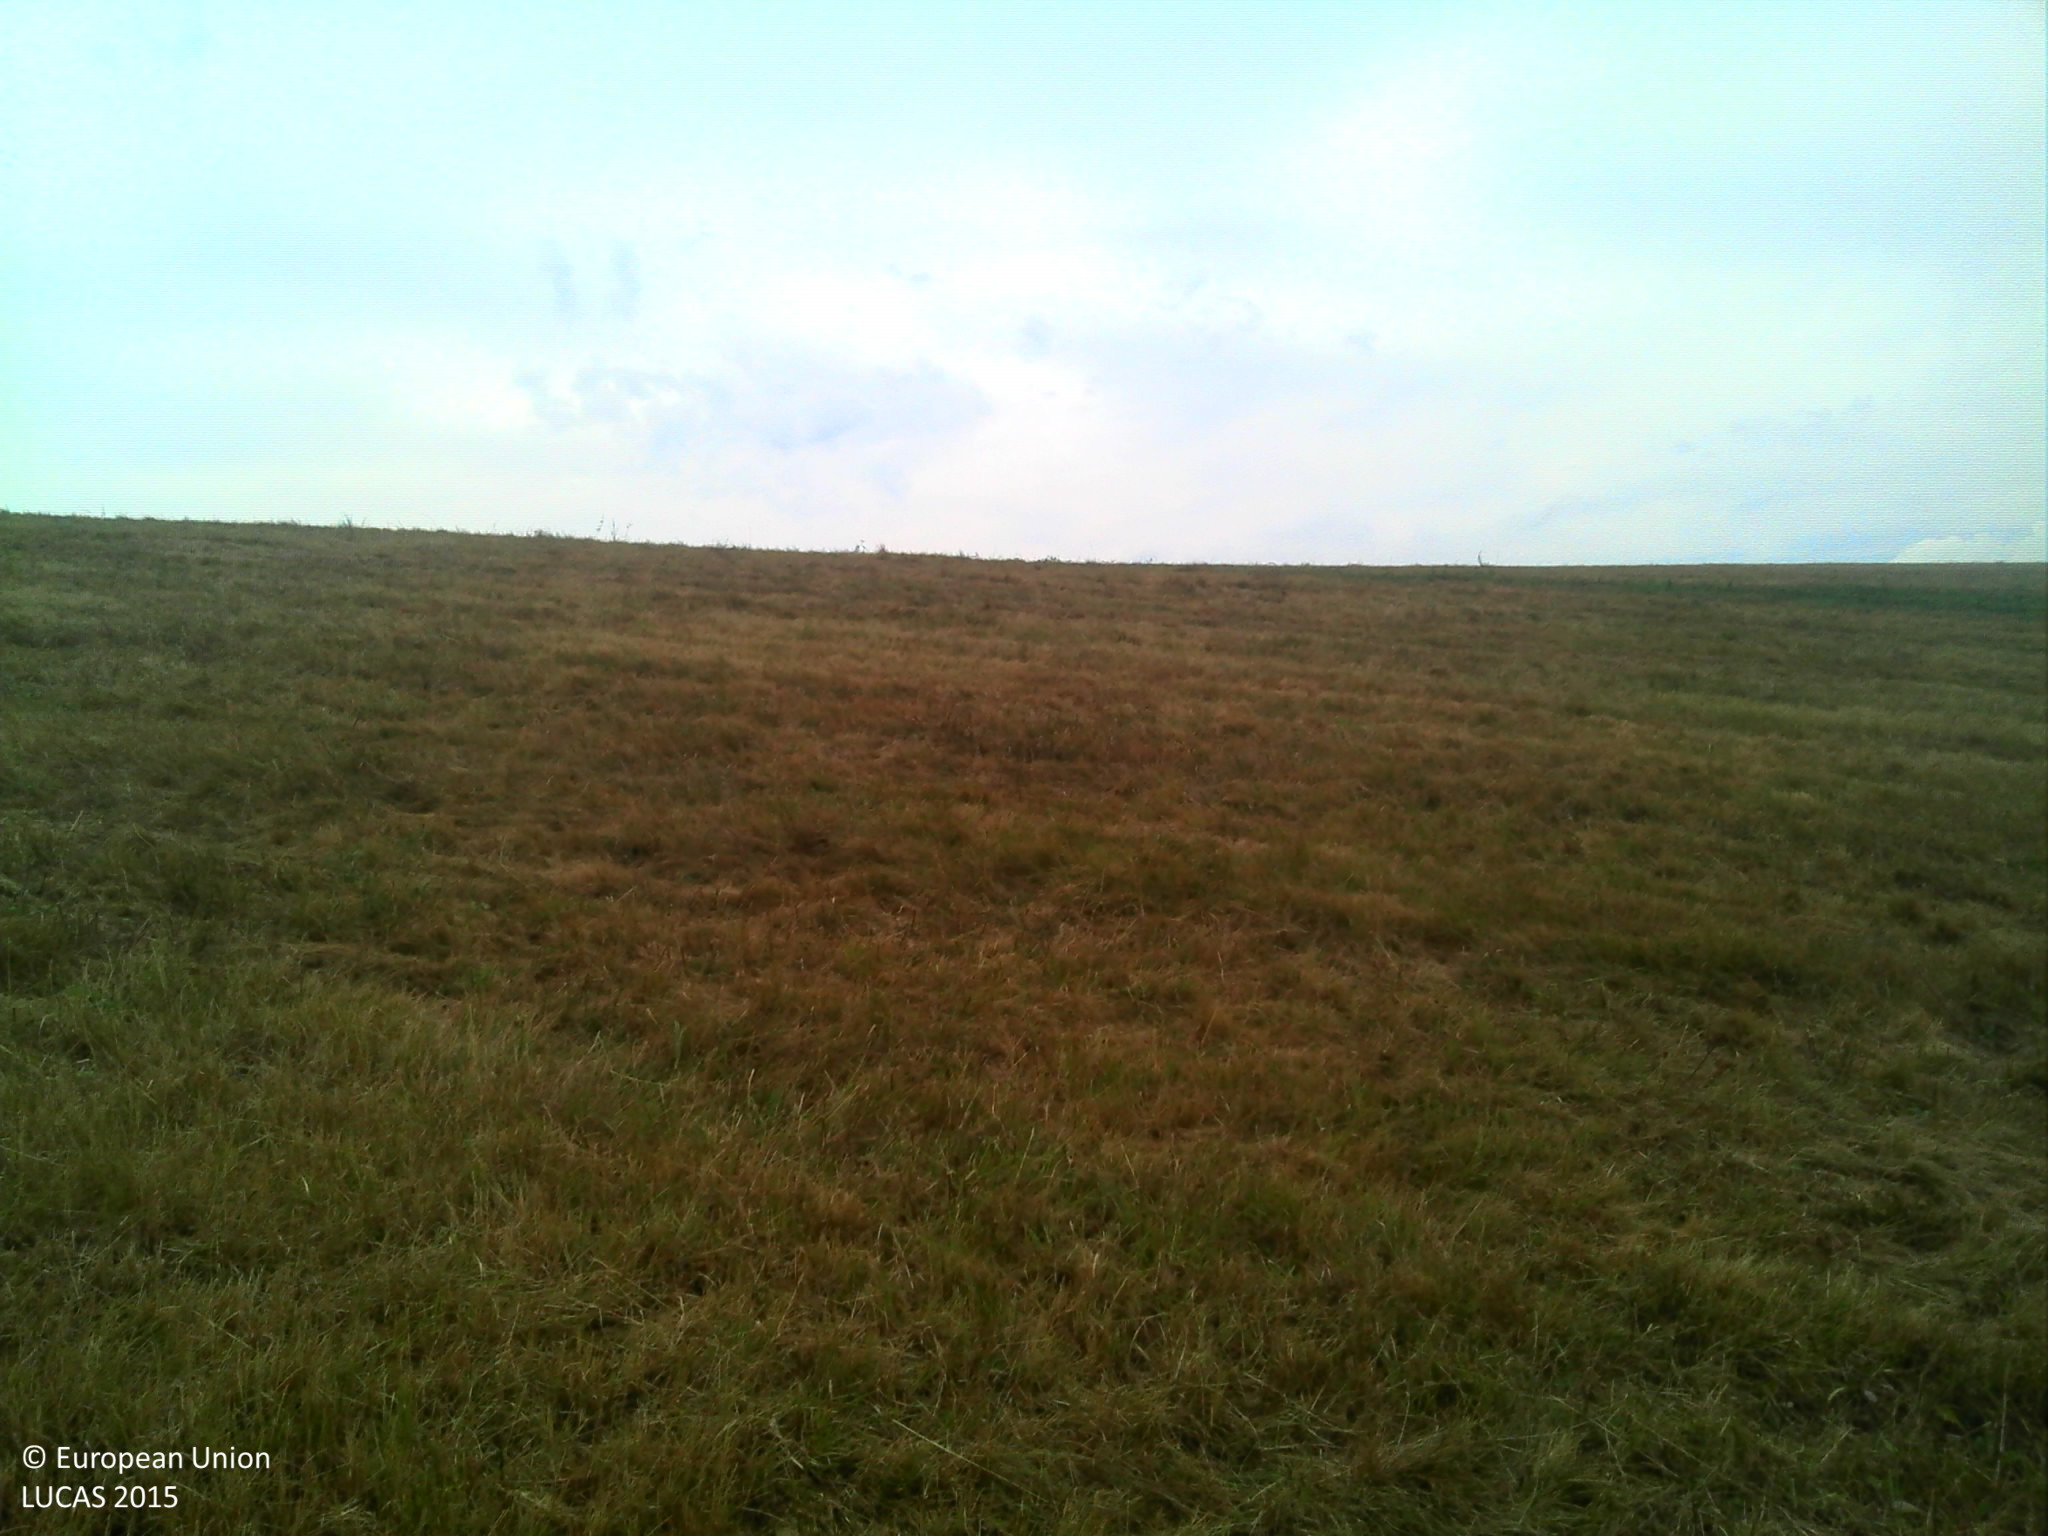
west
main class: Shrubland
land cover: Shrubland without tree cover
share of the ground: > 75 %
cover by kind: shrubs 100 %
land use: Semi-natural and natural areas not in use
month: July
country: FR
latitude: 43.1755
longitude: 0.7630
